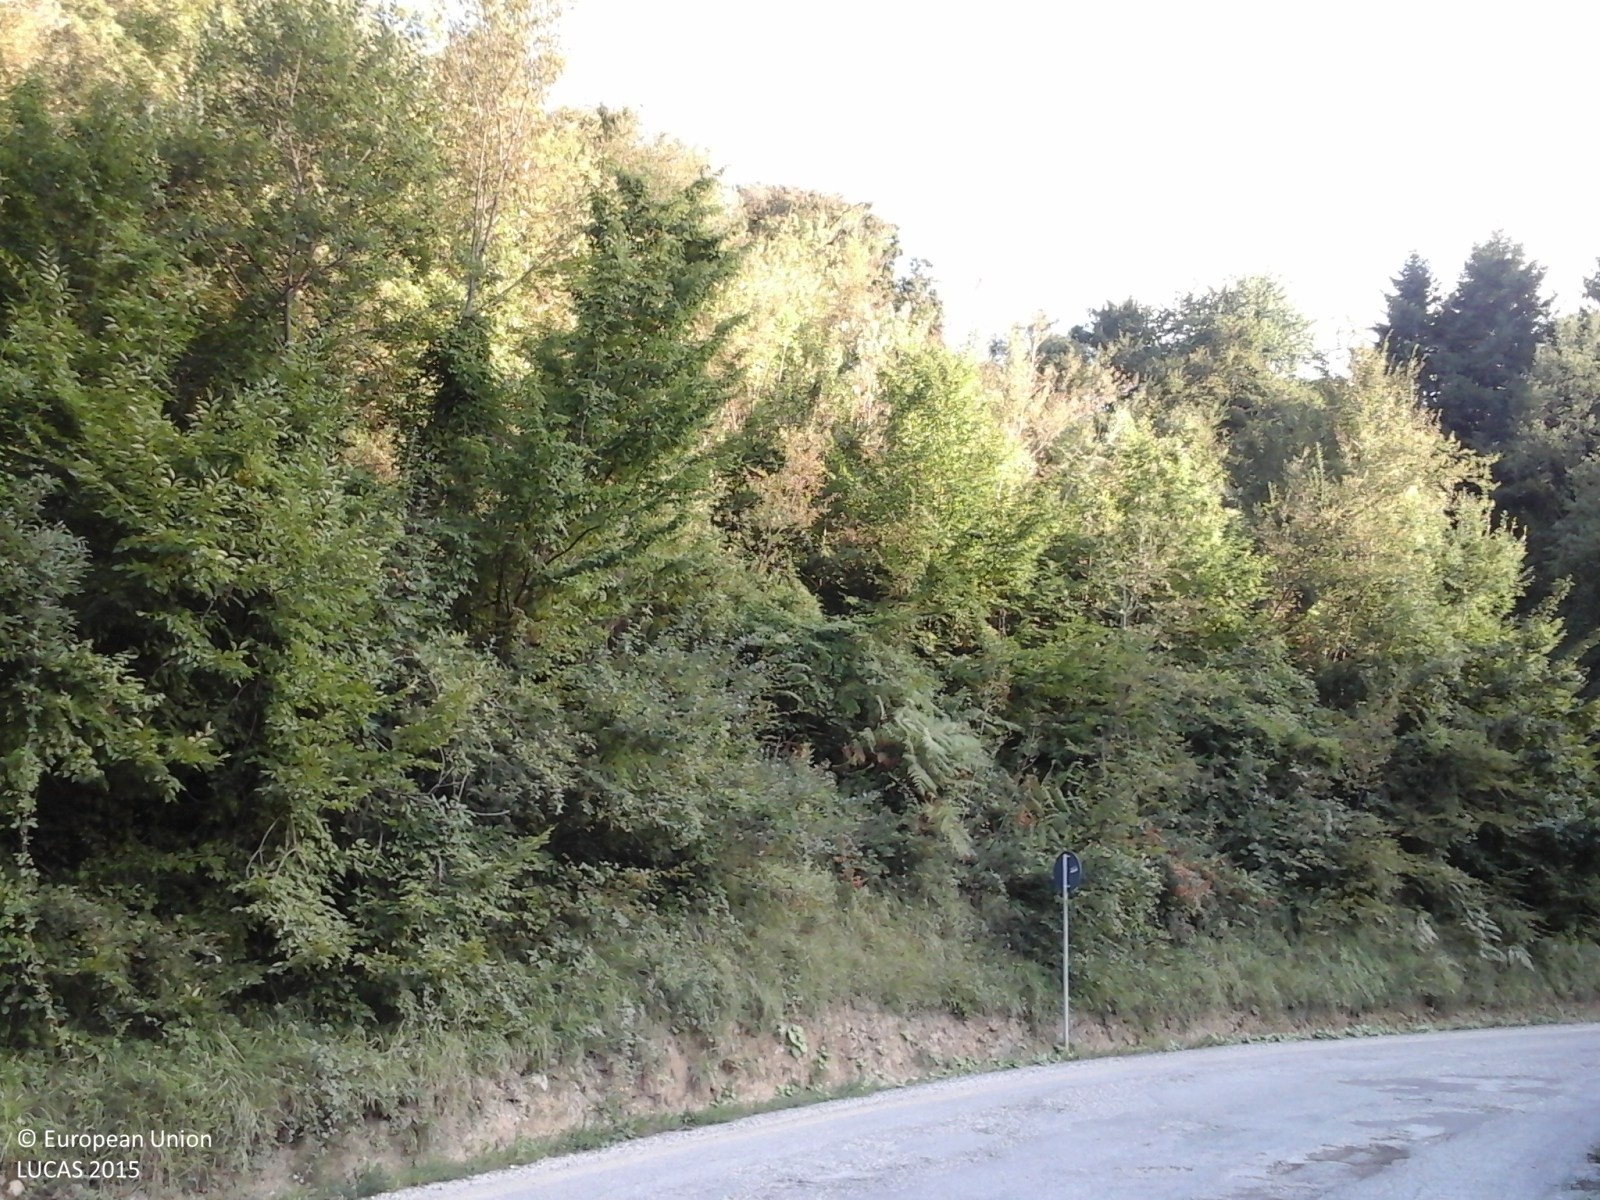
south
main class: Woodland
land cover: Other mixed woodland
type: thermophilous deciduous forest
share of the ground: > 75 %
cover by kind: coniferous forest trees 40 %, broadleaved forest trees 40 %, shrubs 10 %, herbaceous plants 10 %
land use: Semi-natural and natural areas not in use
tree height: > 5 m
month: September
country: IT
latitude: 42.7383
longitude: 13.4955
